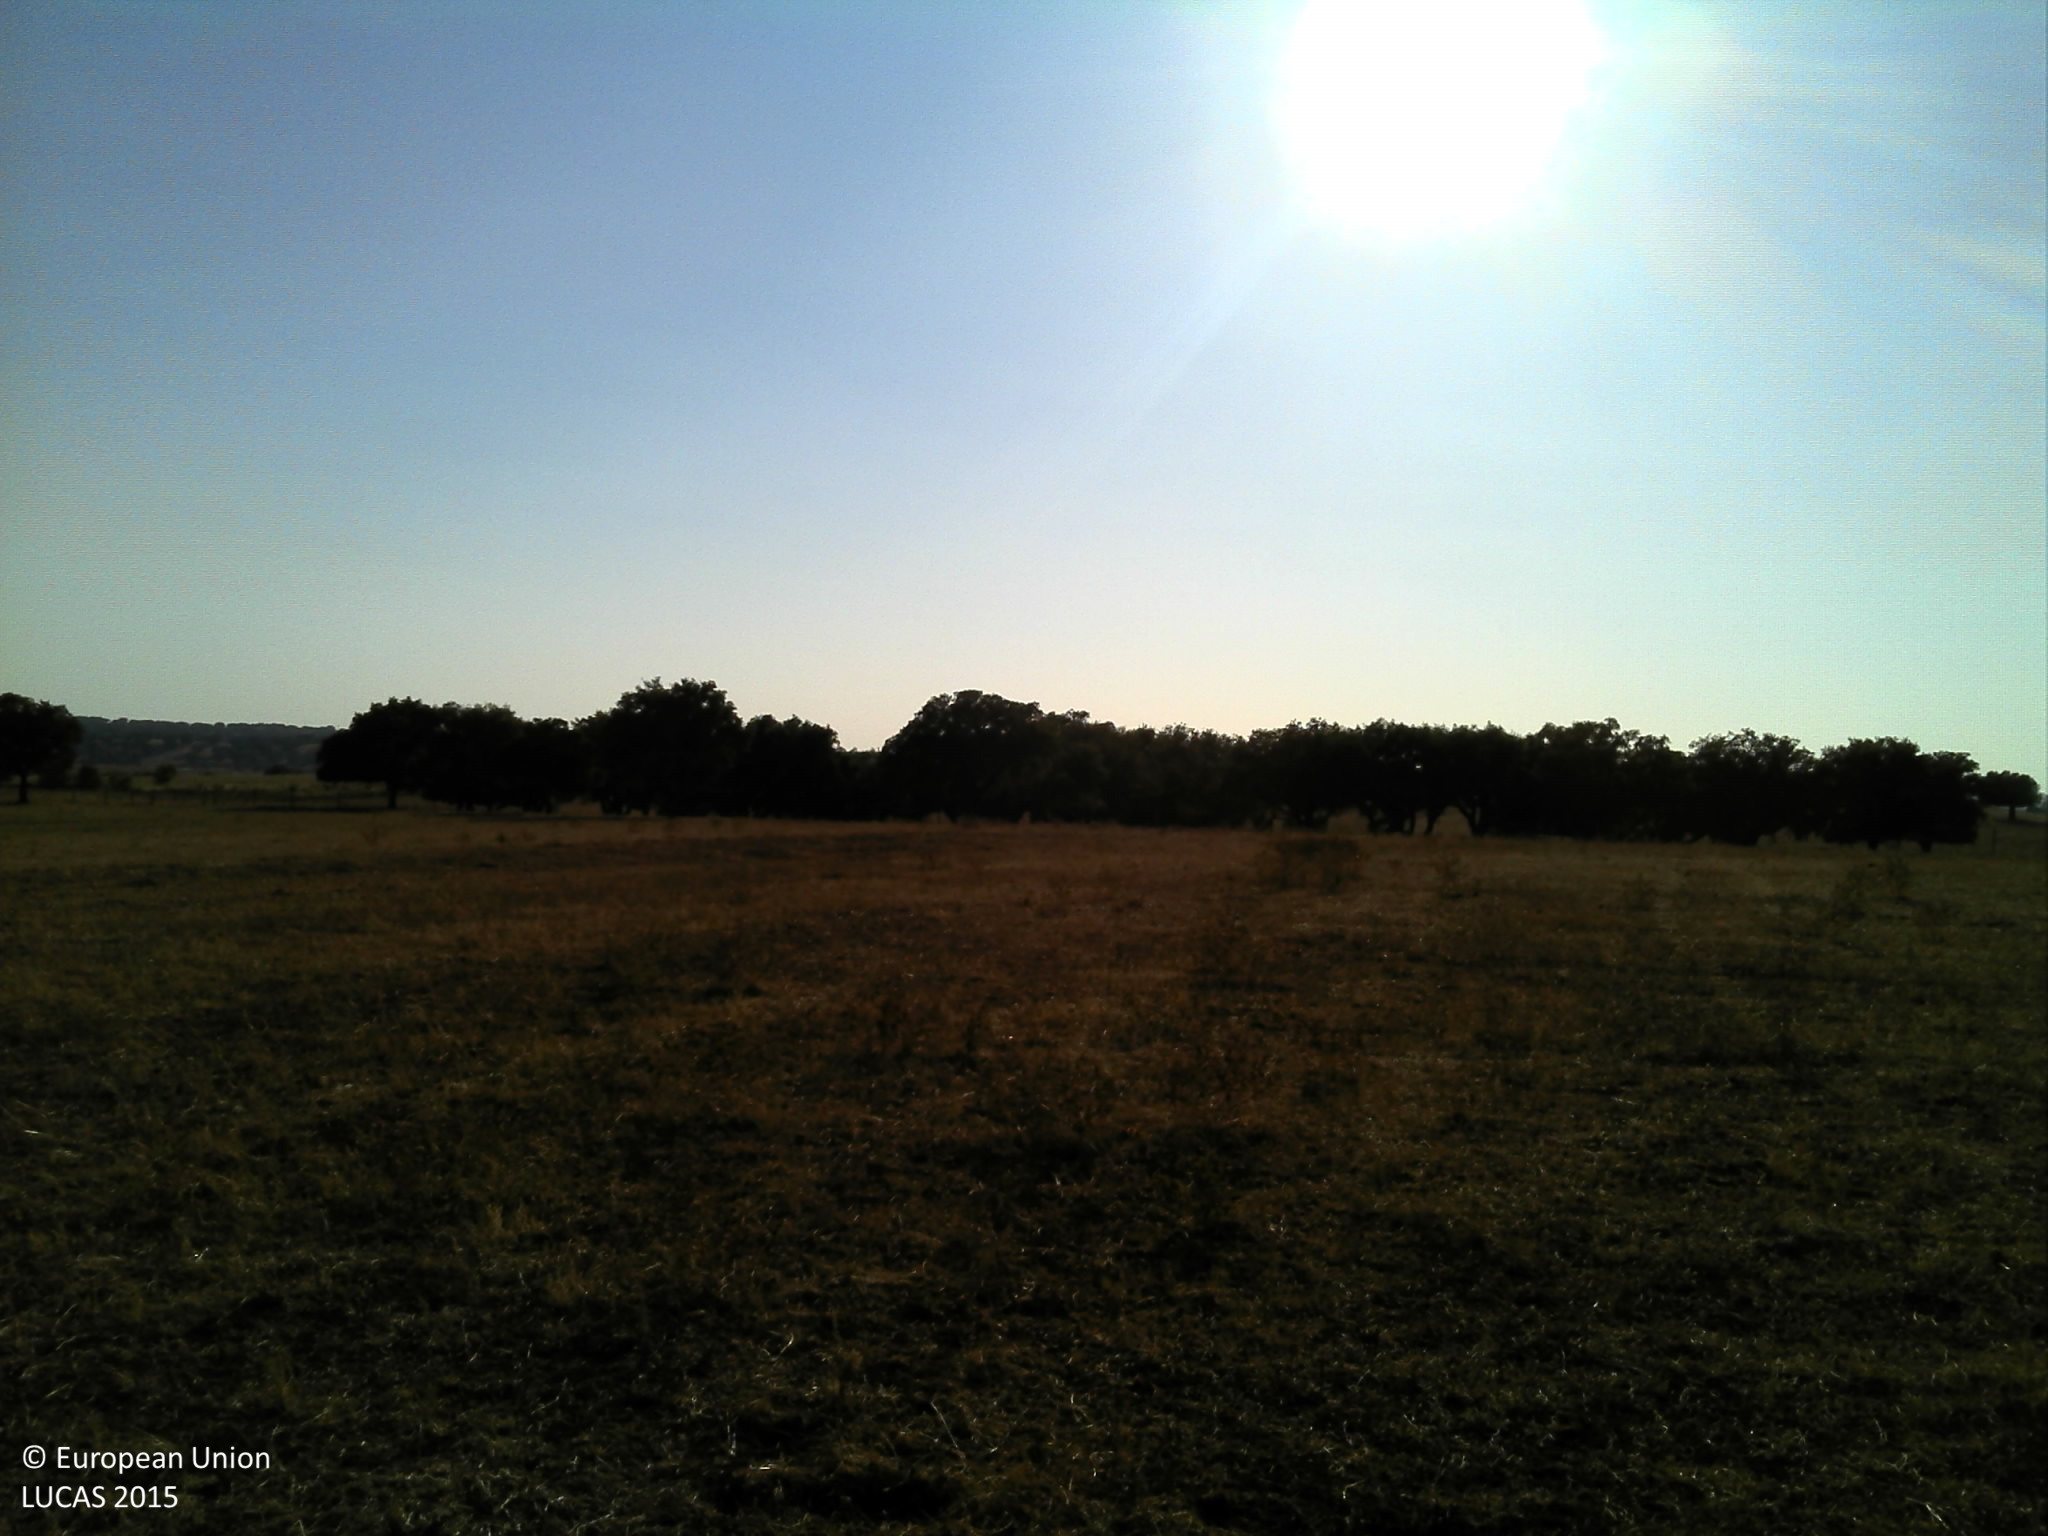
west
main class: Grassland
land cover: Spontaneously vegetated surfaces
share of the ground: 10 - 25 %
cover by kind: unconsolidated bare surface 90 %, herbaceous plants 10 %
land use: Agriculture (excluding fallow land and kitchen gardens)
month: July
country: PT
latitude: 38.5389
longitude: -7.6664
